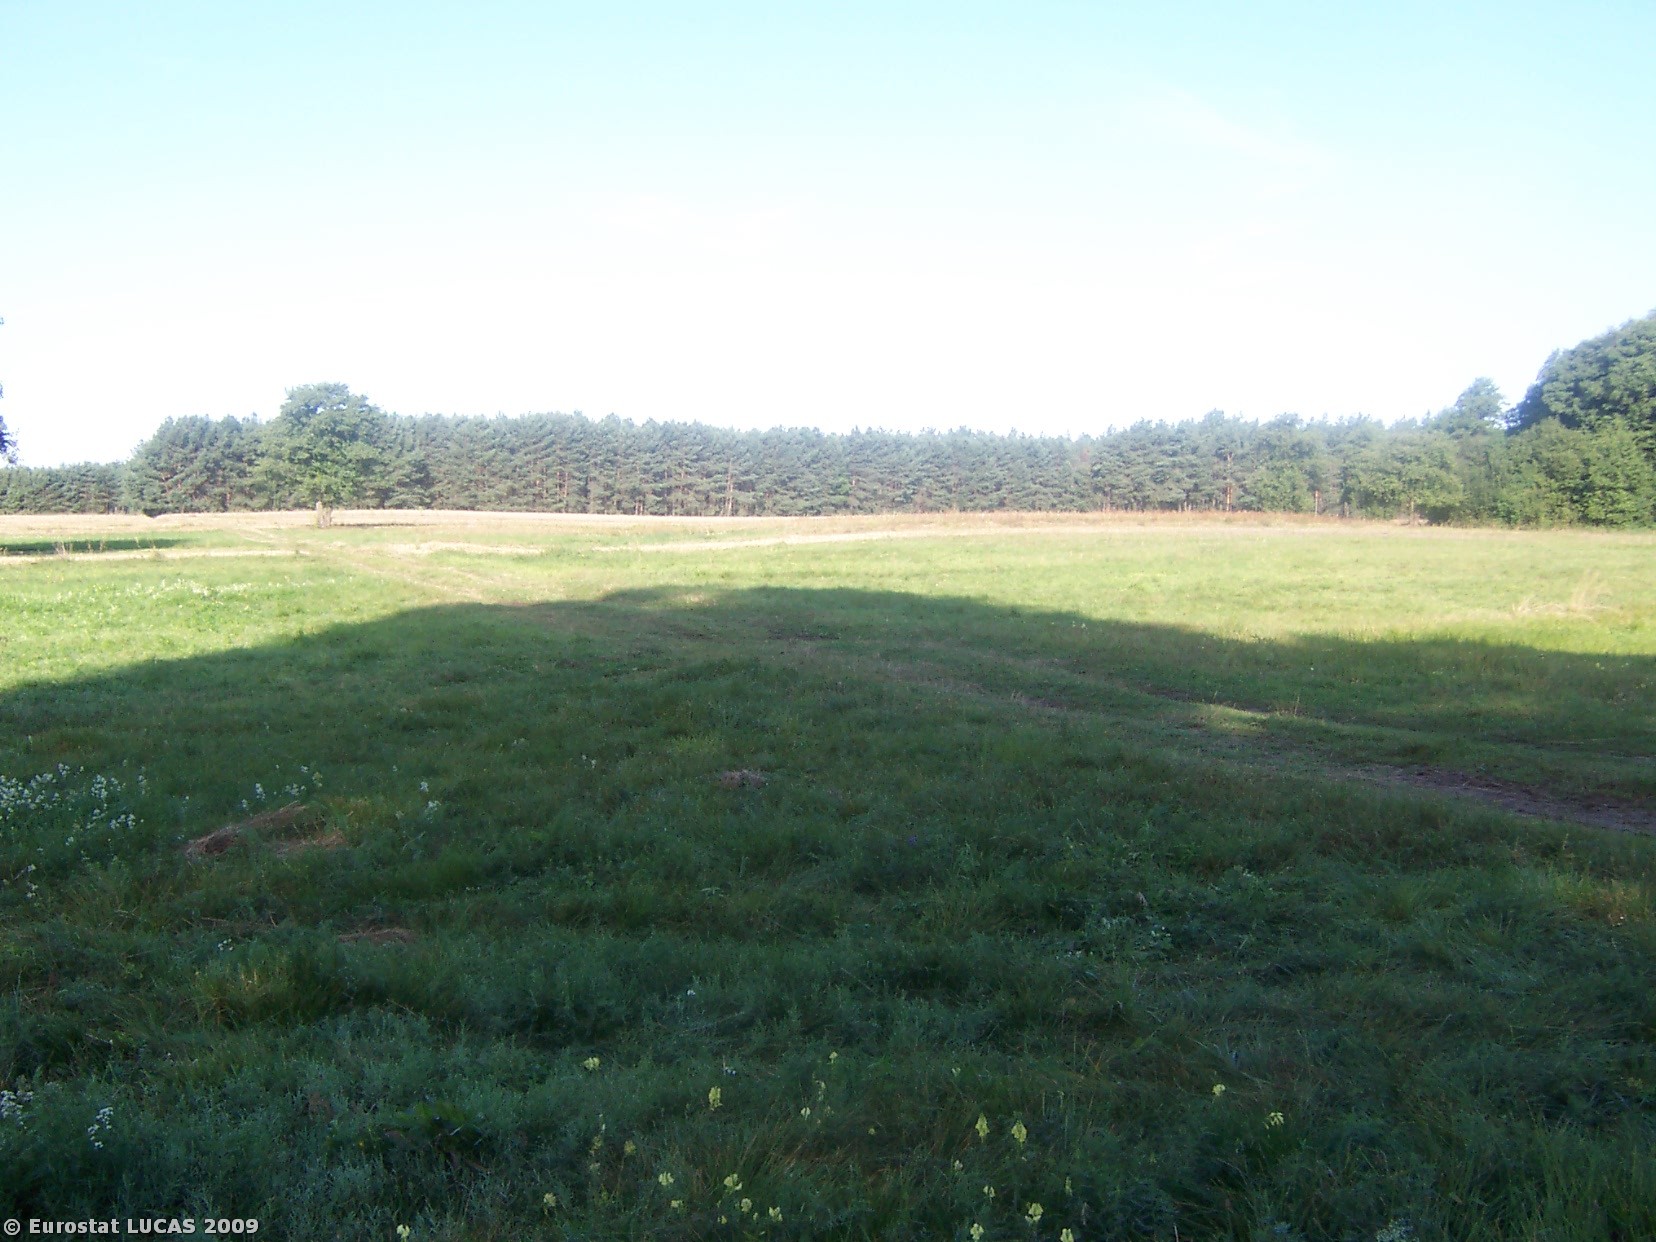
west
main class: Grassland
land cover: Grassland without tree/shrub cover
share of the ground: > 75 %
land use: Agriculture (excluding fallow land and kitchen gardens)
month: August
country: PL
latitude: 52.6522
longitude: 21.1173
